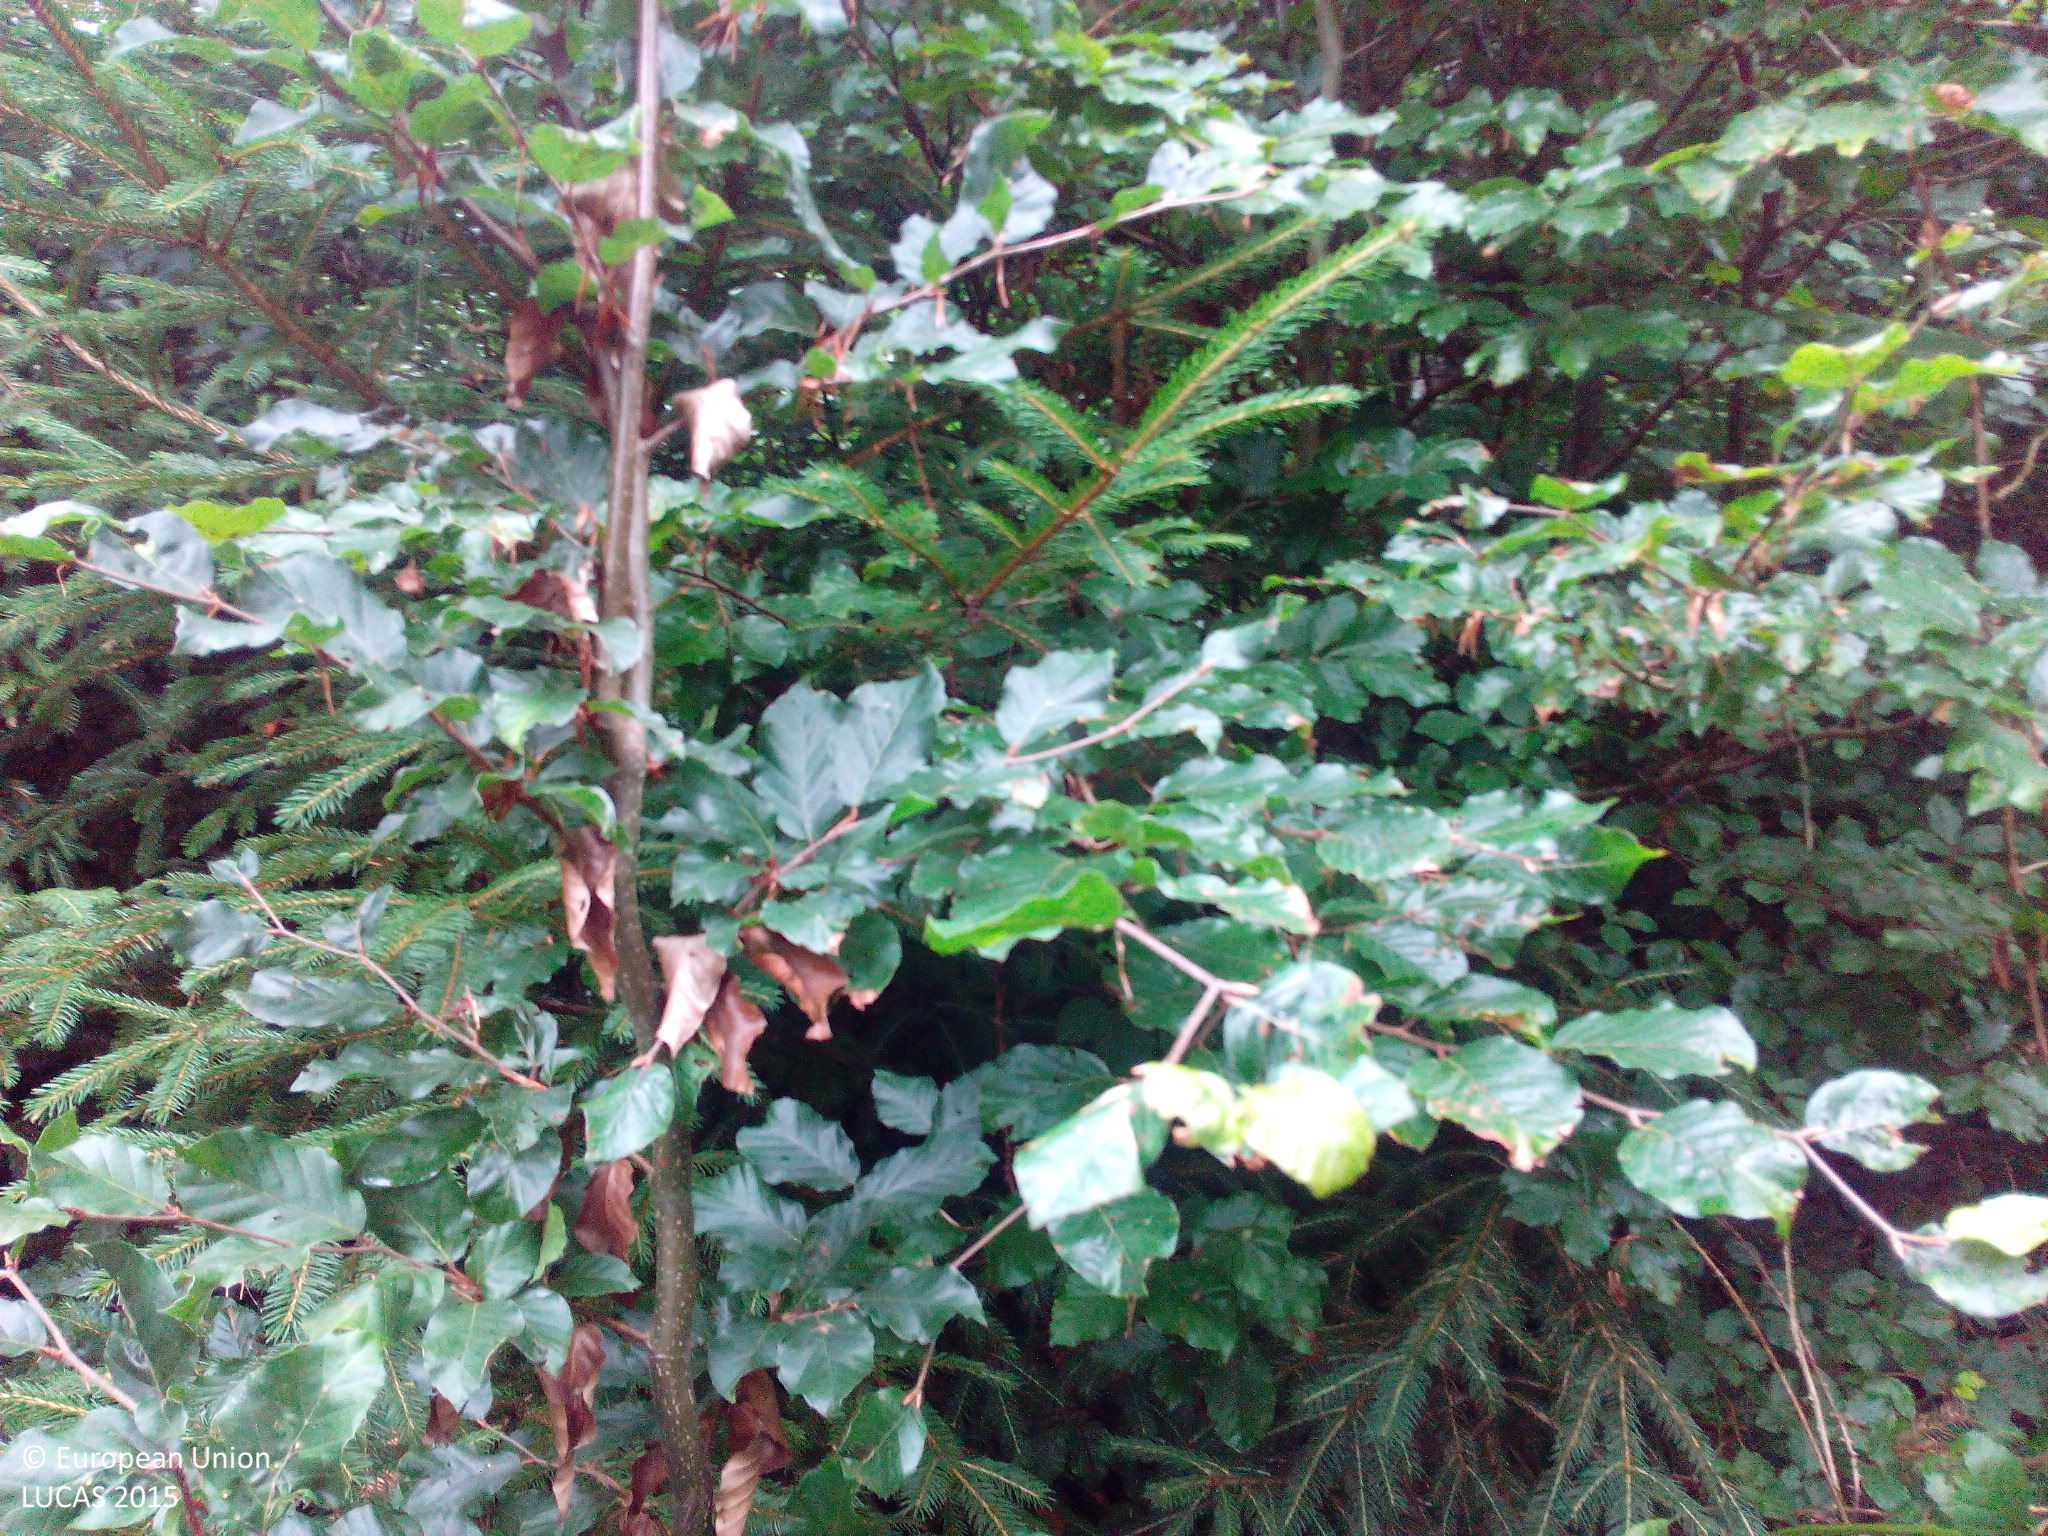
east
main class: Woodland
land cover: Other mixed woodland
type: hemiboreal forest and nemoral coniferous forest and mixed broadleaved-coniferous forest
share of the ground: > 75 %
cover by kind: broadleaved forest trees 50 %, coniferous forest trees 30 %, shrubs 10 %, herbaceous plants 10 %
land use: Forestry
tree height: < 5 m
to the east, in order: Other mixed woodland; Broadleaved woodland; Shrubland with sparse tree cover; Other mixed woodland; Grass margins; Tracks; Spontaneously vegetated surfaces; Other mixed woodland; Tracks; Other mixed woodland; Broadleaved woodland
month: July
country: DE
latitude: 47.7715
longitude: 9.3200
